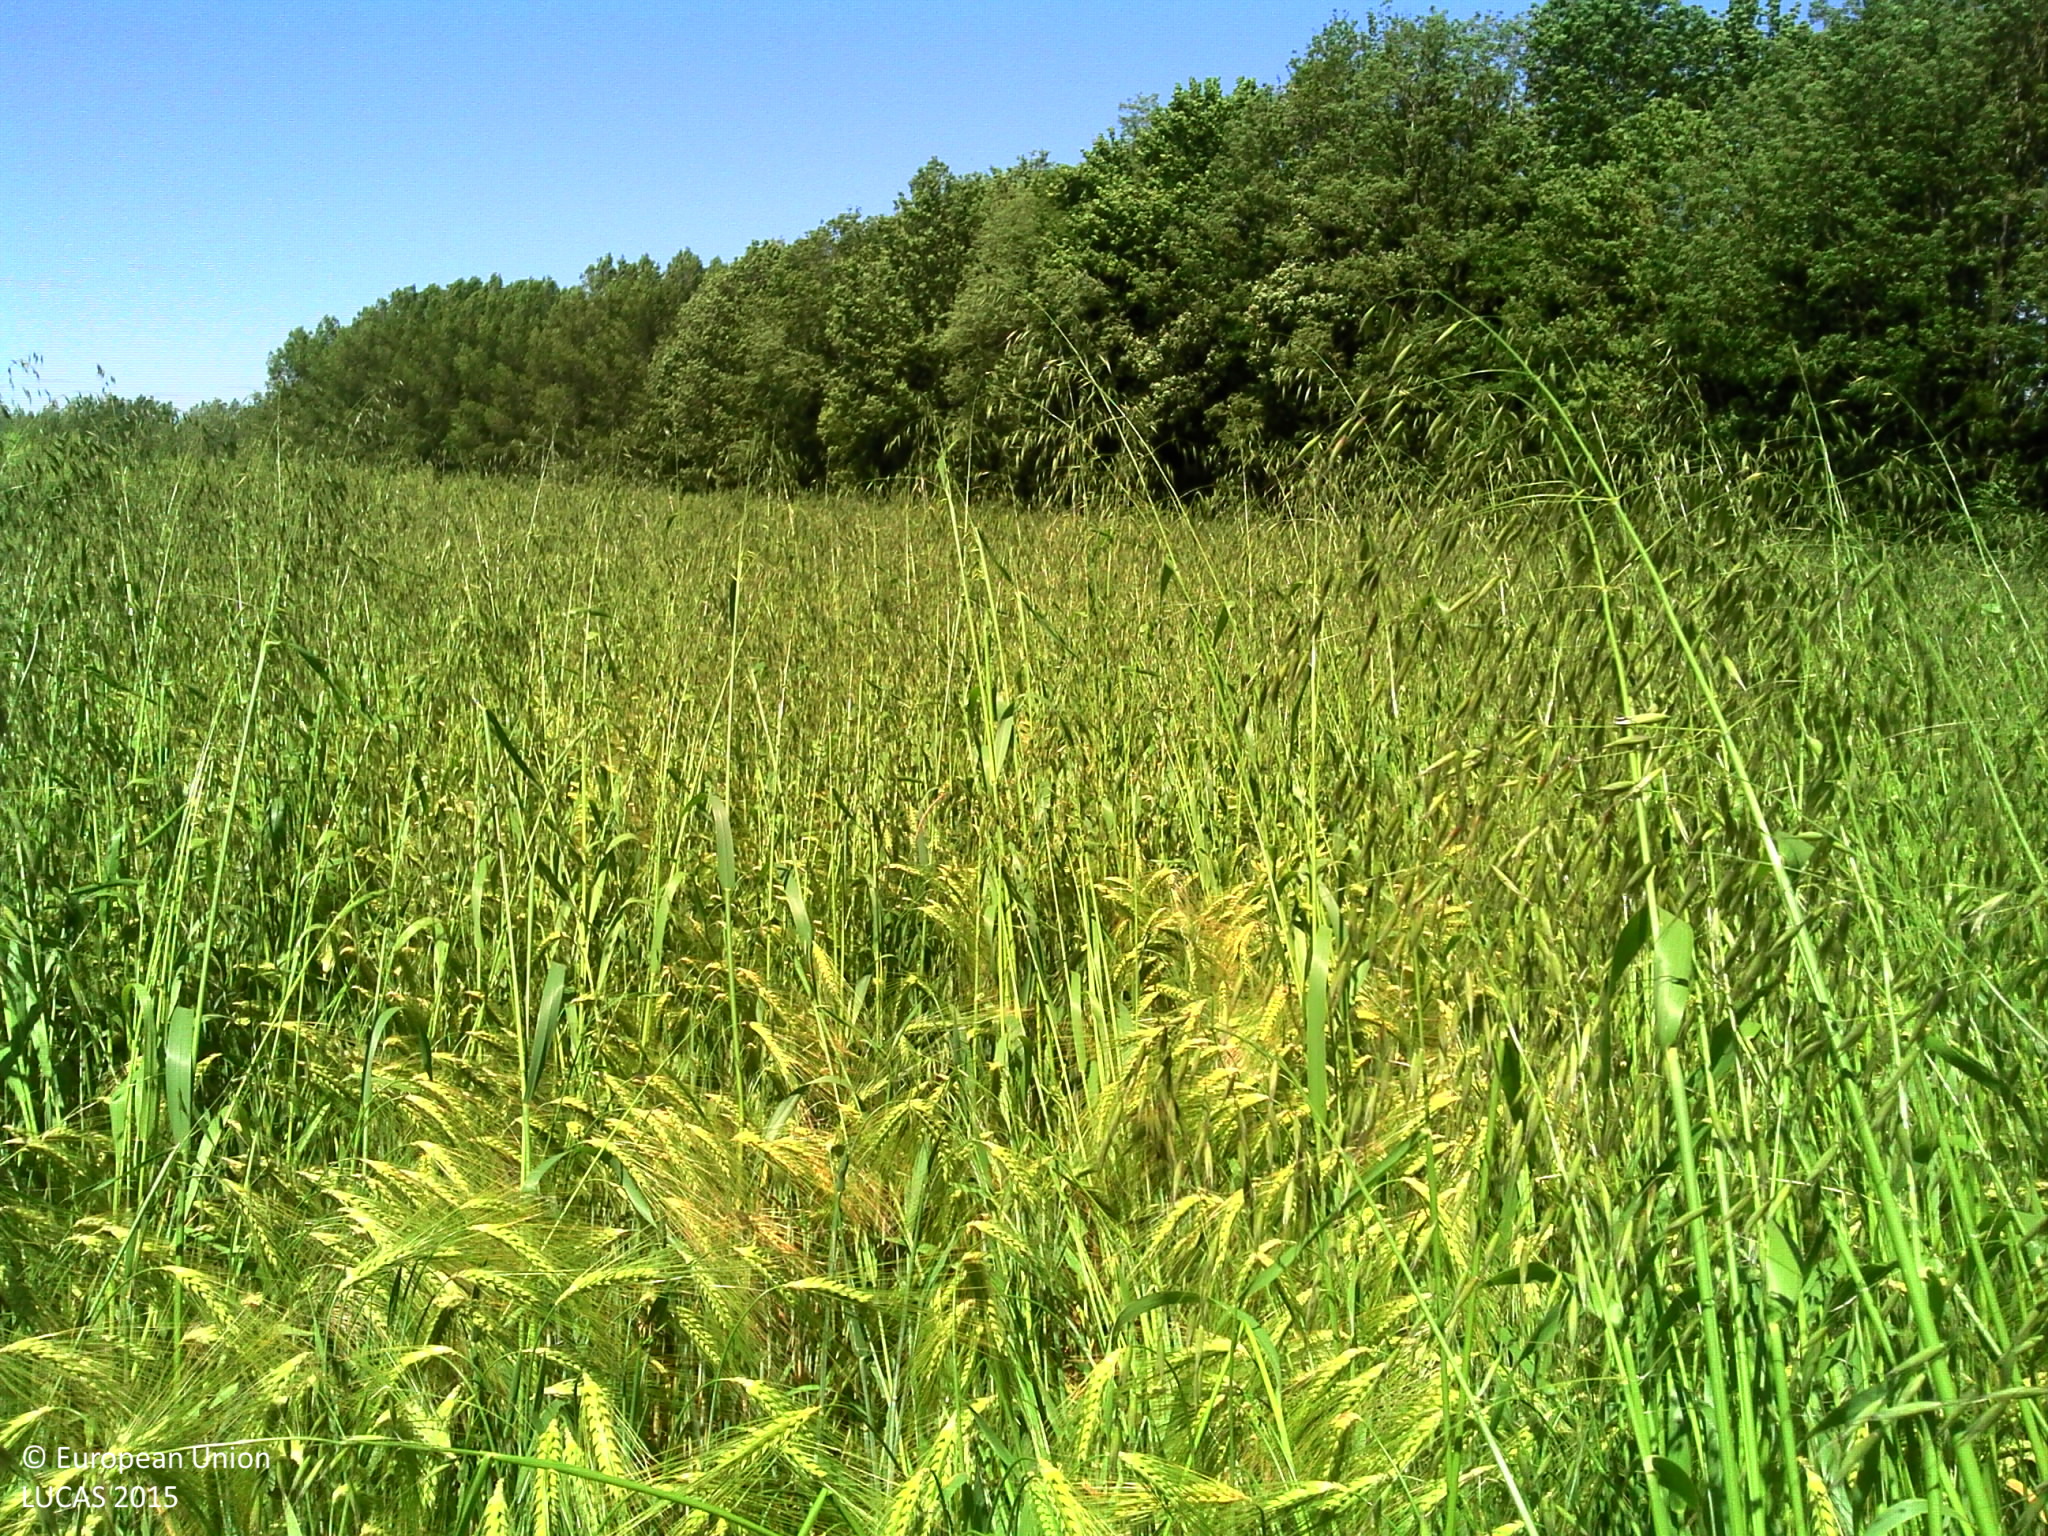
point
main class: Cropland
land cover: Mixed cereals for fodder
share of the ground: > 75 %
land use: Agriculture (excluding fallow land and kitchen gardens)
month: June
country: FR
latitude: 47.2287
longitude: 5.0479
